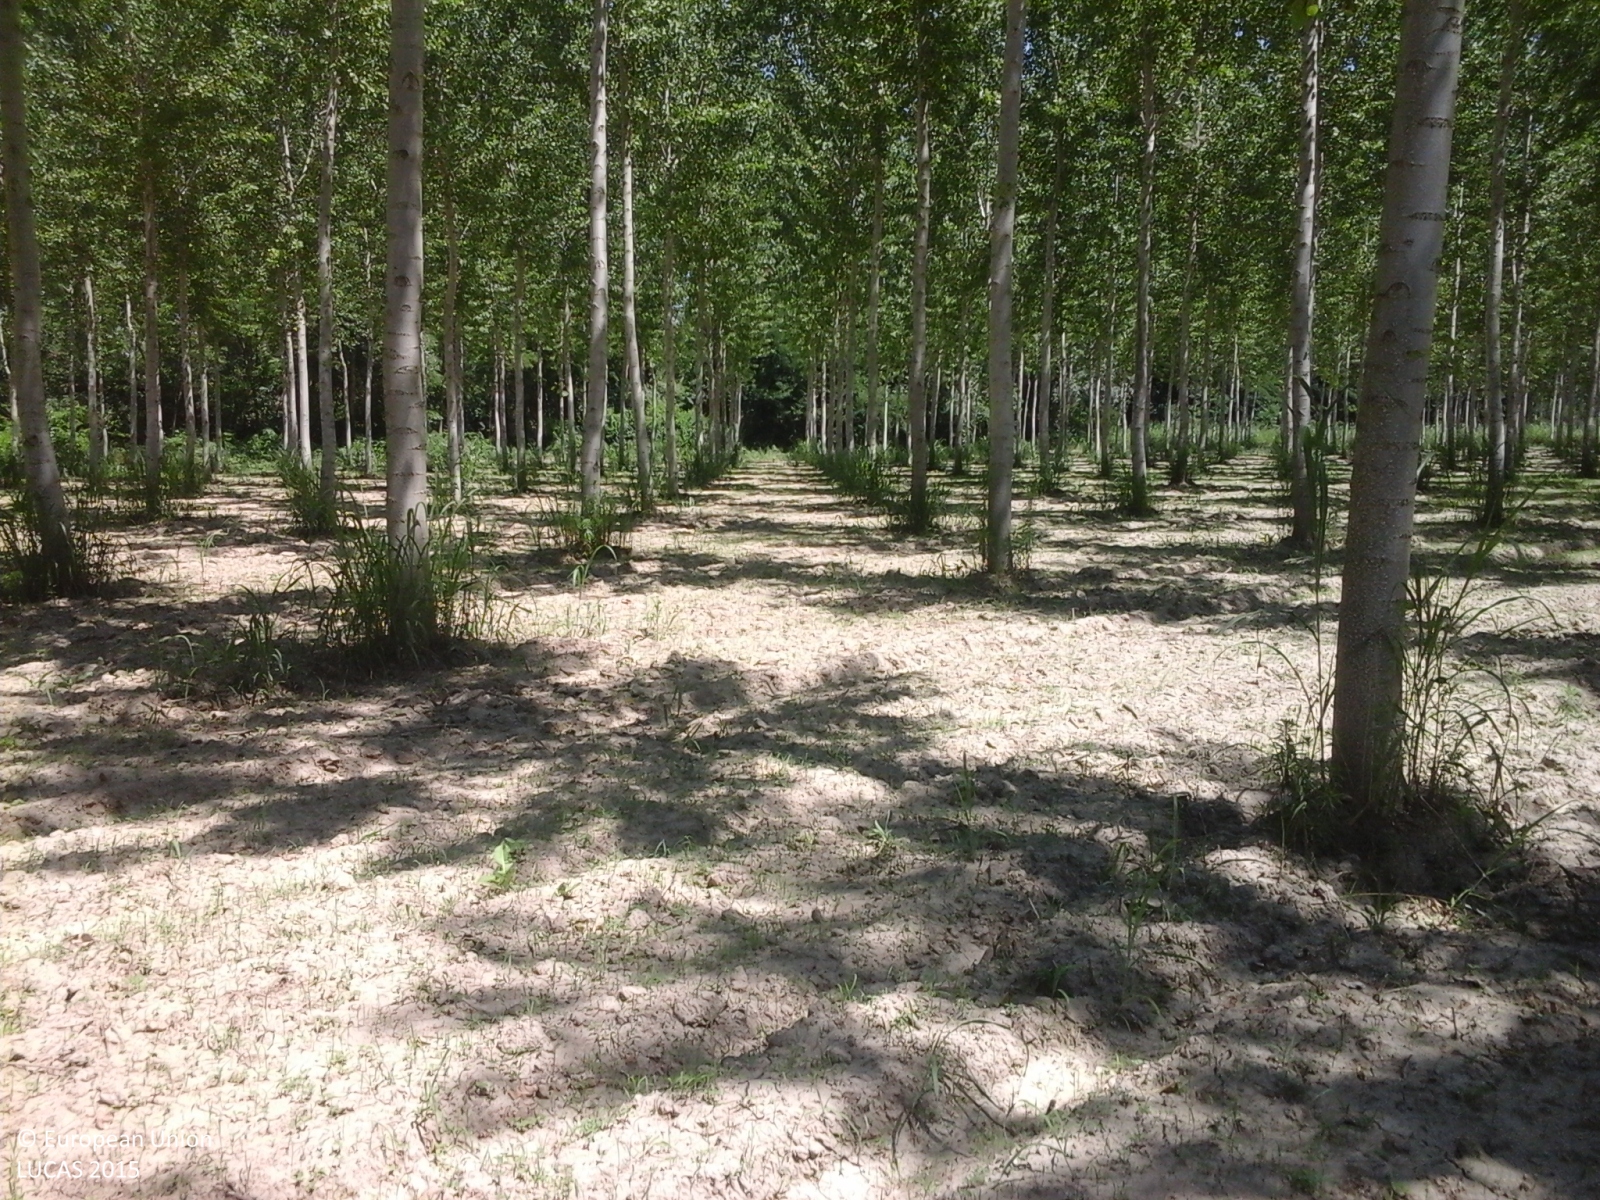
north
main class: Woodland
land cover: Broadleaved woodland
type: non-riverine alder, birch or aspen forest
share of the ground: > 75 %
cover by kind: broadleaved forest trees 85 %, unconsolidated bare surface 15 %
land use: Forestry
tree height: > 5 m
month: June
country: IT
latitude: 45.0450
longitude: 8.6441
